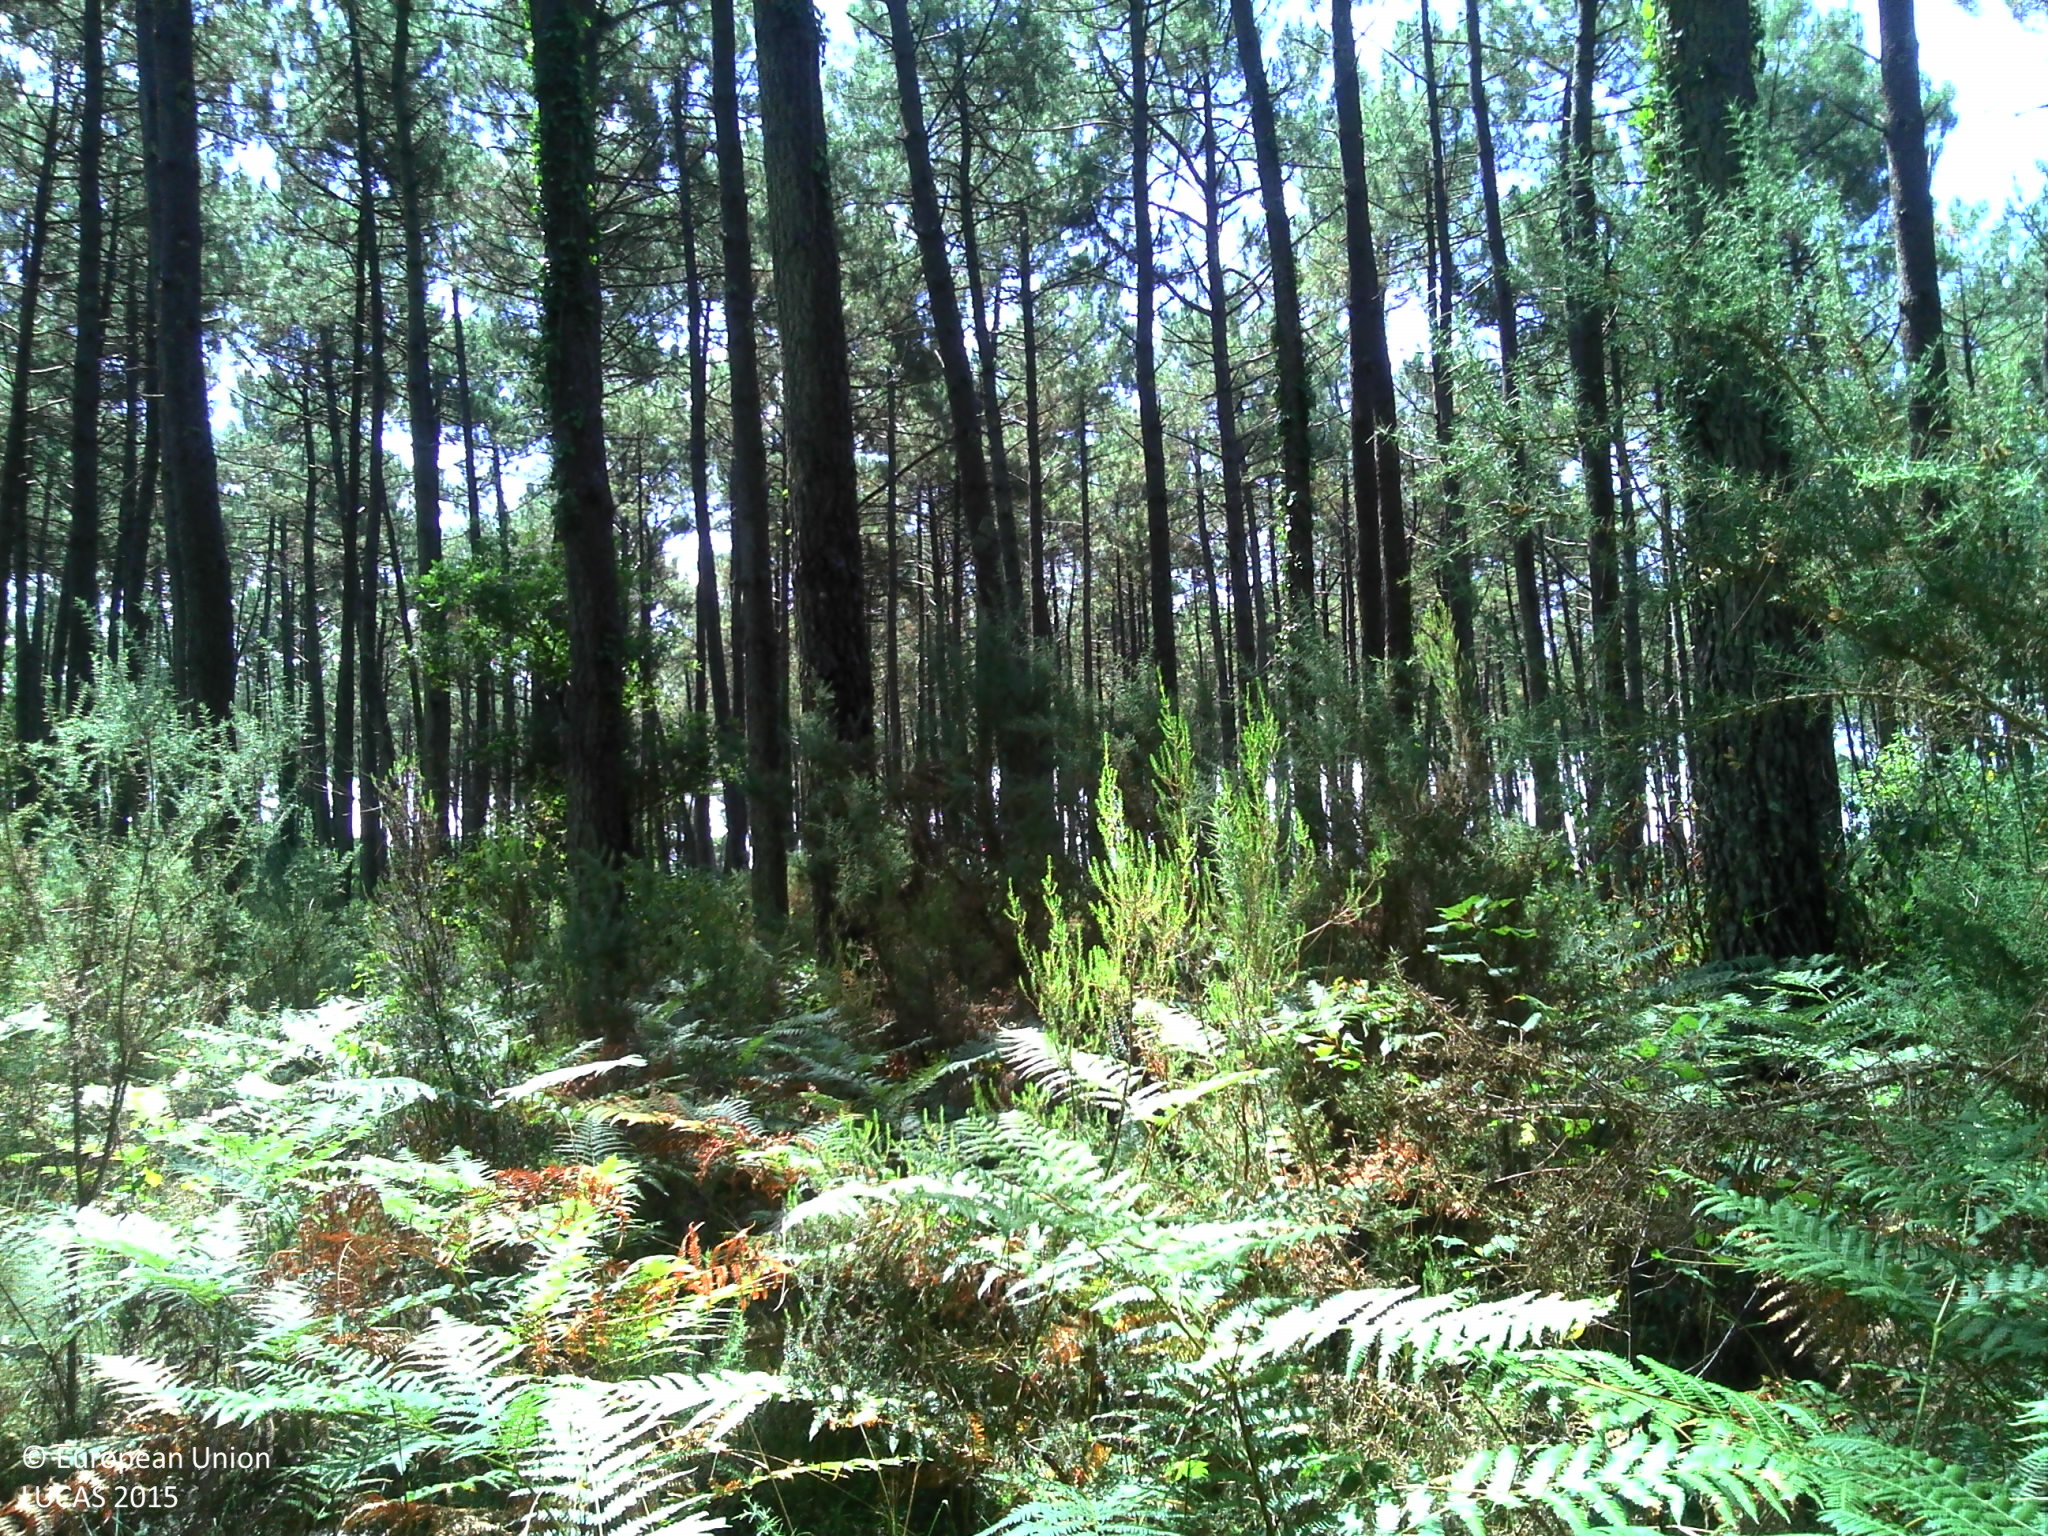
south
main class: Woodland
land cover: Pine dominated coniferous woodland
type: coniferous forest of the mediterranean region
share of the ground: > 75 %
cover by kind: coniferous forest trees 80 %, shrubs 10 %, herbaceous plants 10 %
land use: Forestry
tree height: > 5 m
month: July
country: FR
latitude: 44.1746
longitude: -1.2401
